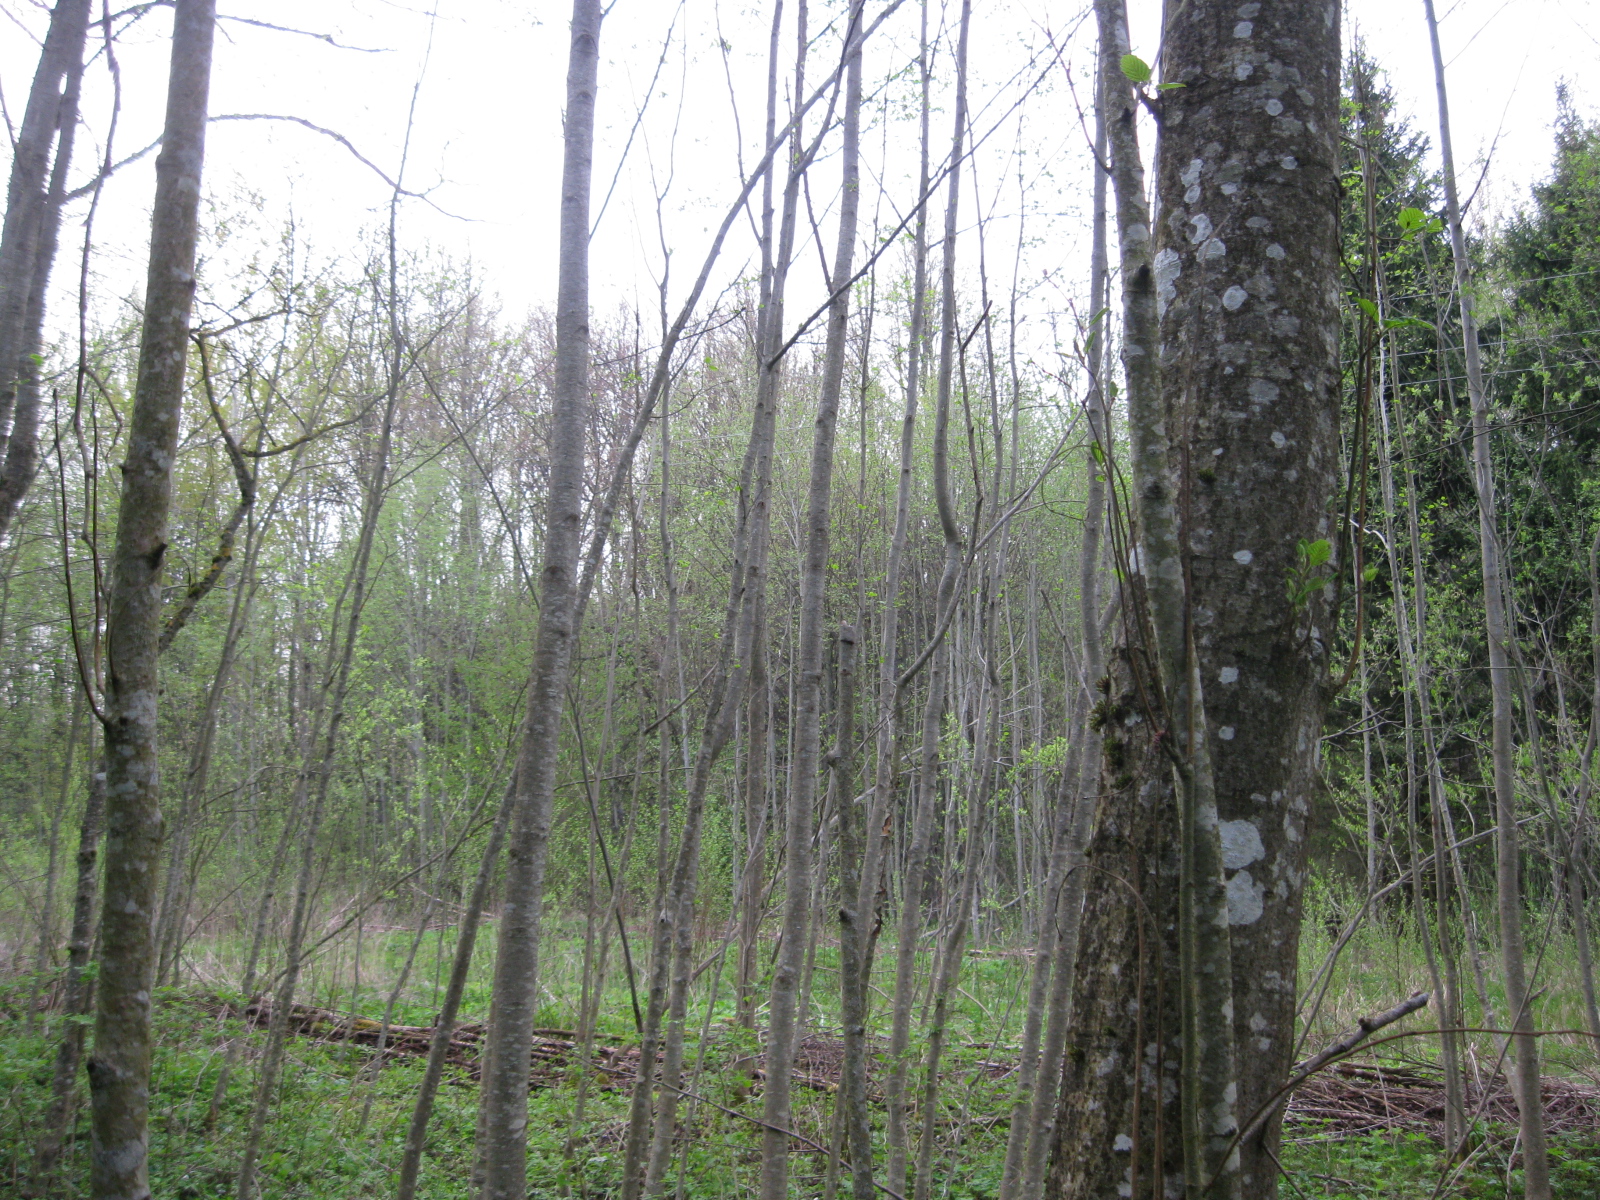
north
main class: Woodland
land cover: Broadleaved woodland
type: non-riverine alder, birch or aspen forest
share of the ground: > 75 %
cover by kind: broadleaved forest trees 85 %, herbaceous plants 10 %, lichens and mosses 5 %
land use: Forestry
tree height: > 5 m
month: May
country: LT
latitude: 56.2221
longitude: 24.4660
